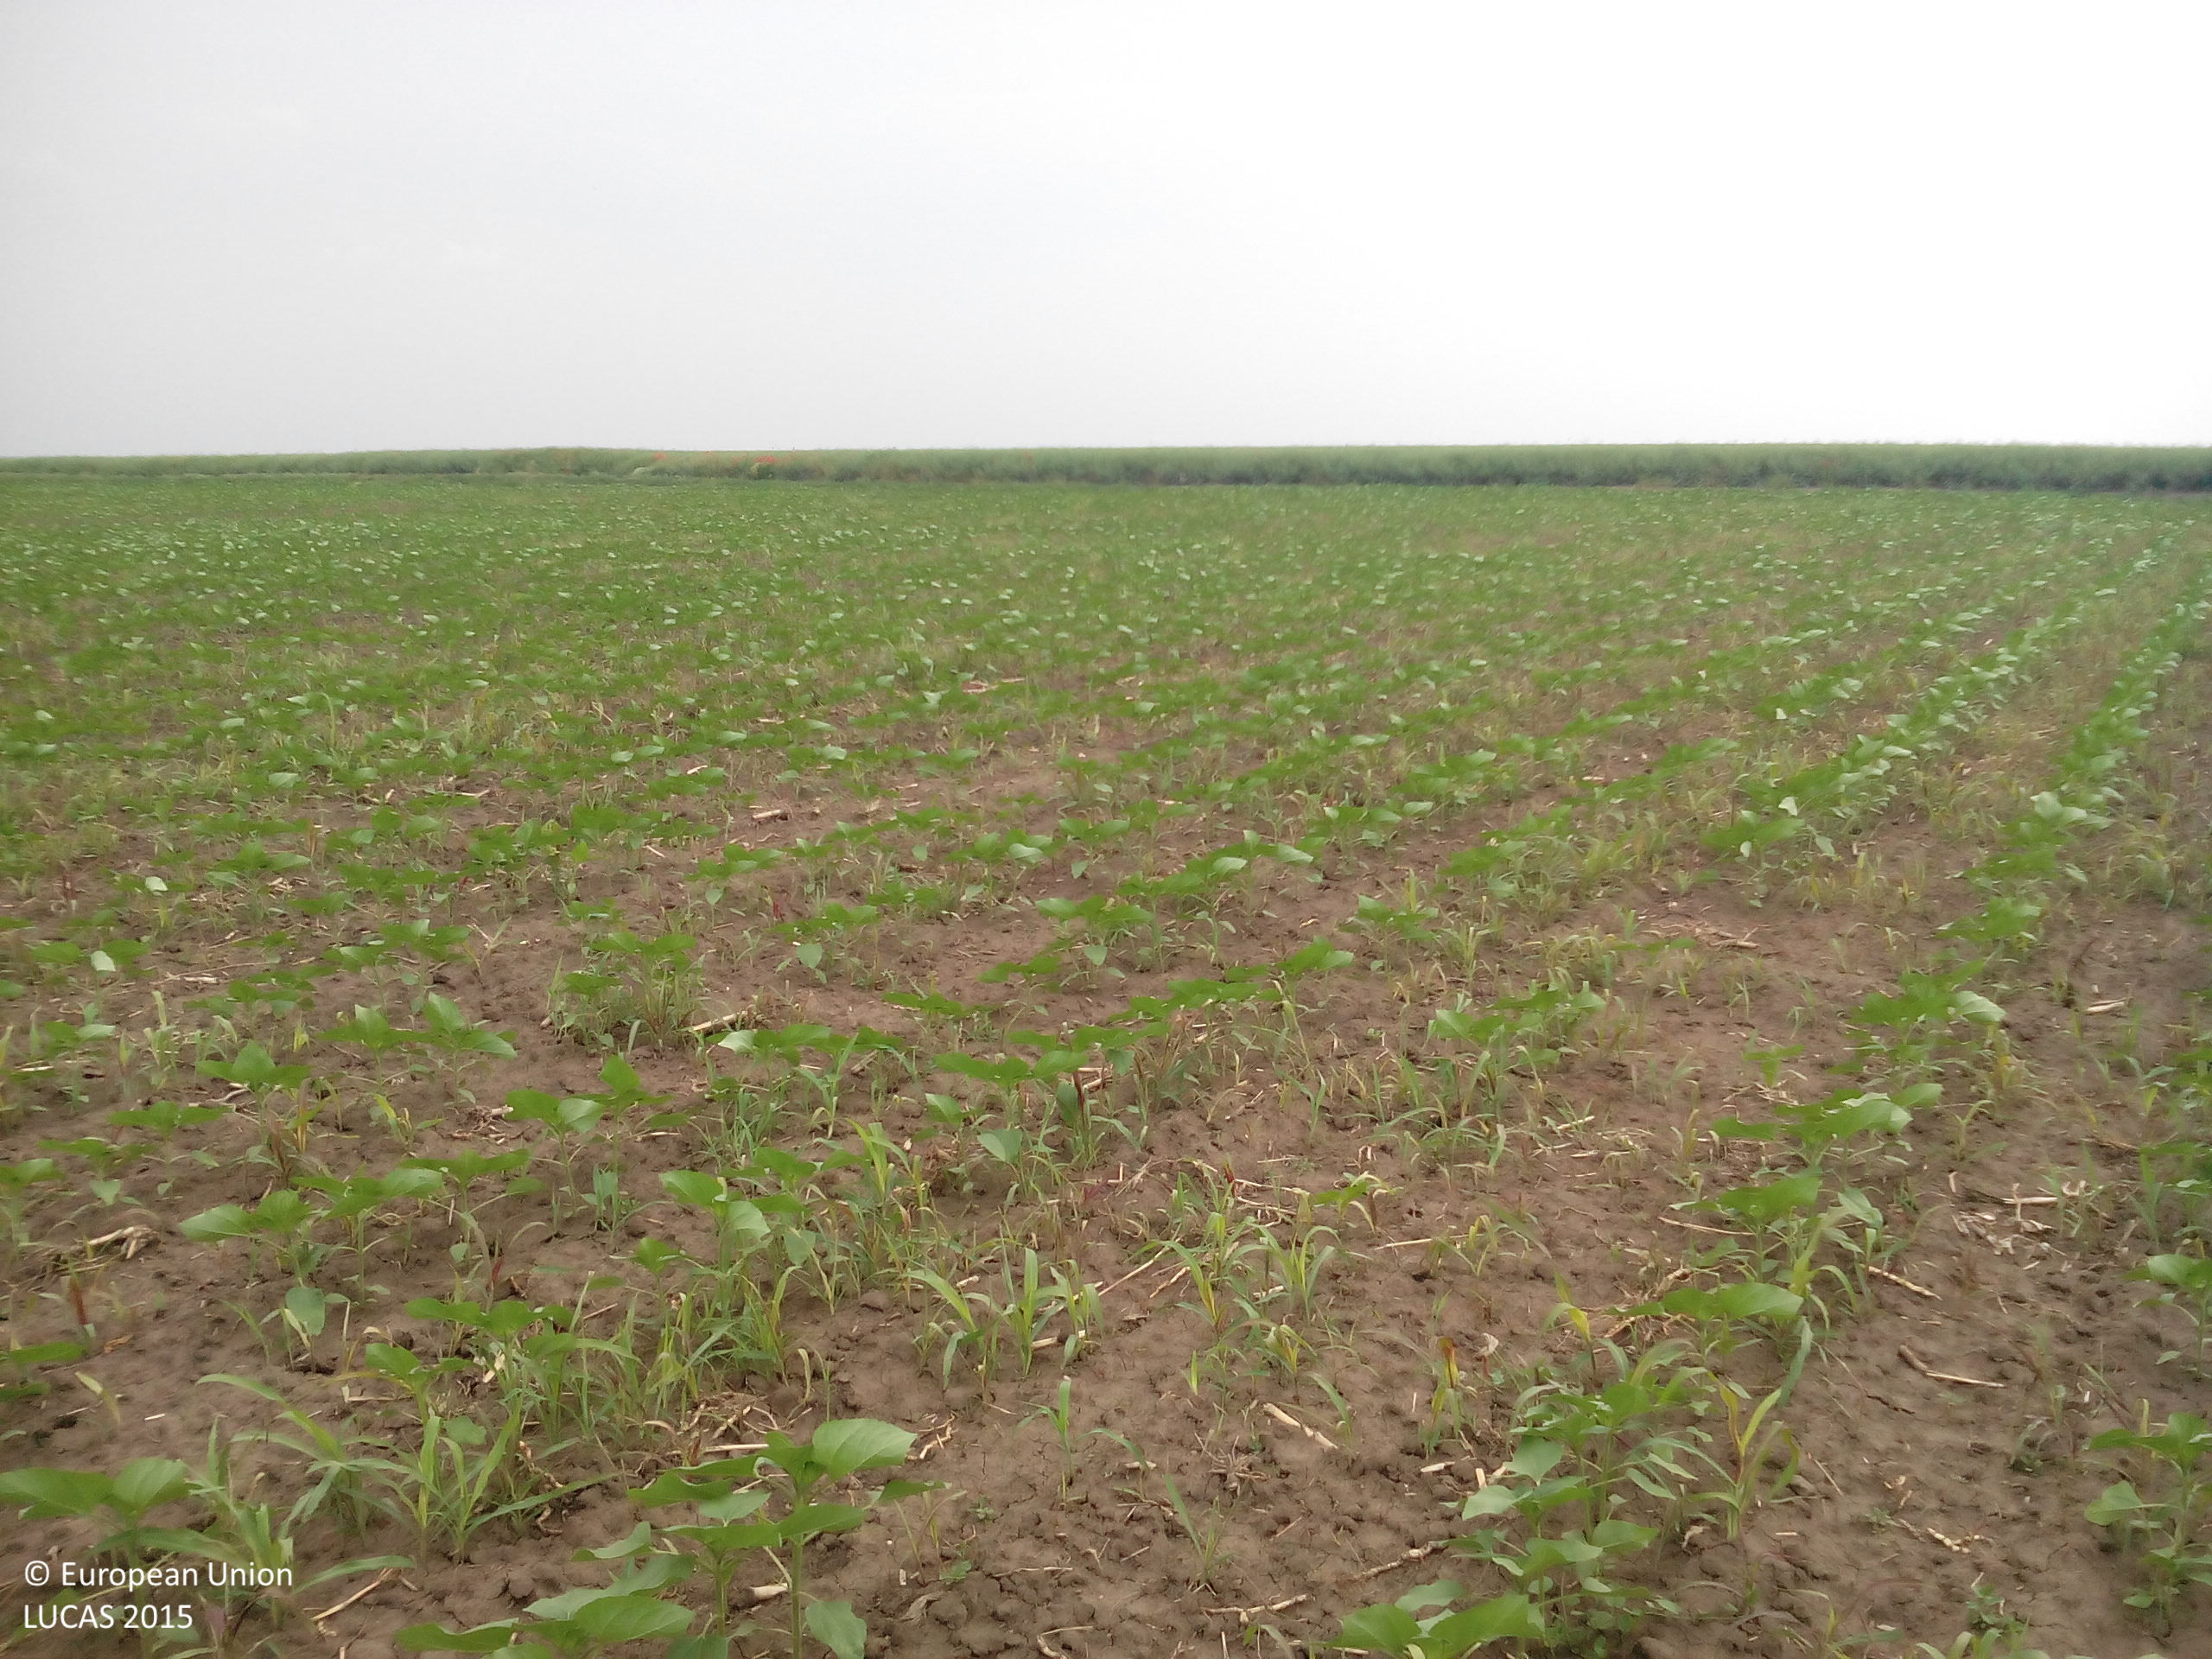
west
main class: Cropland
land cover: Sunflower
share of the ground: 25 - 50 %
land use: Agriculture (excluding fallow land and kitchen gardens)
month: May
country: BG
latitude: 43.6070
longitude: 24.1934
